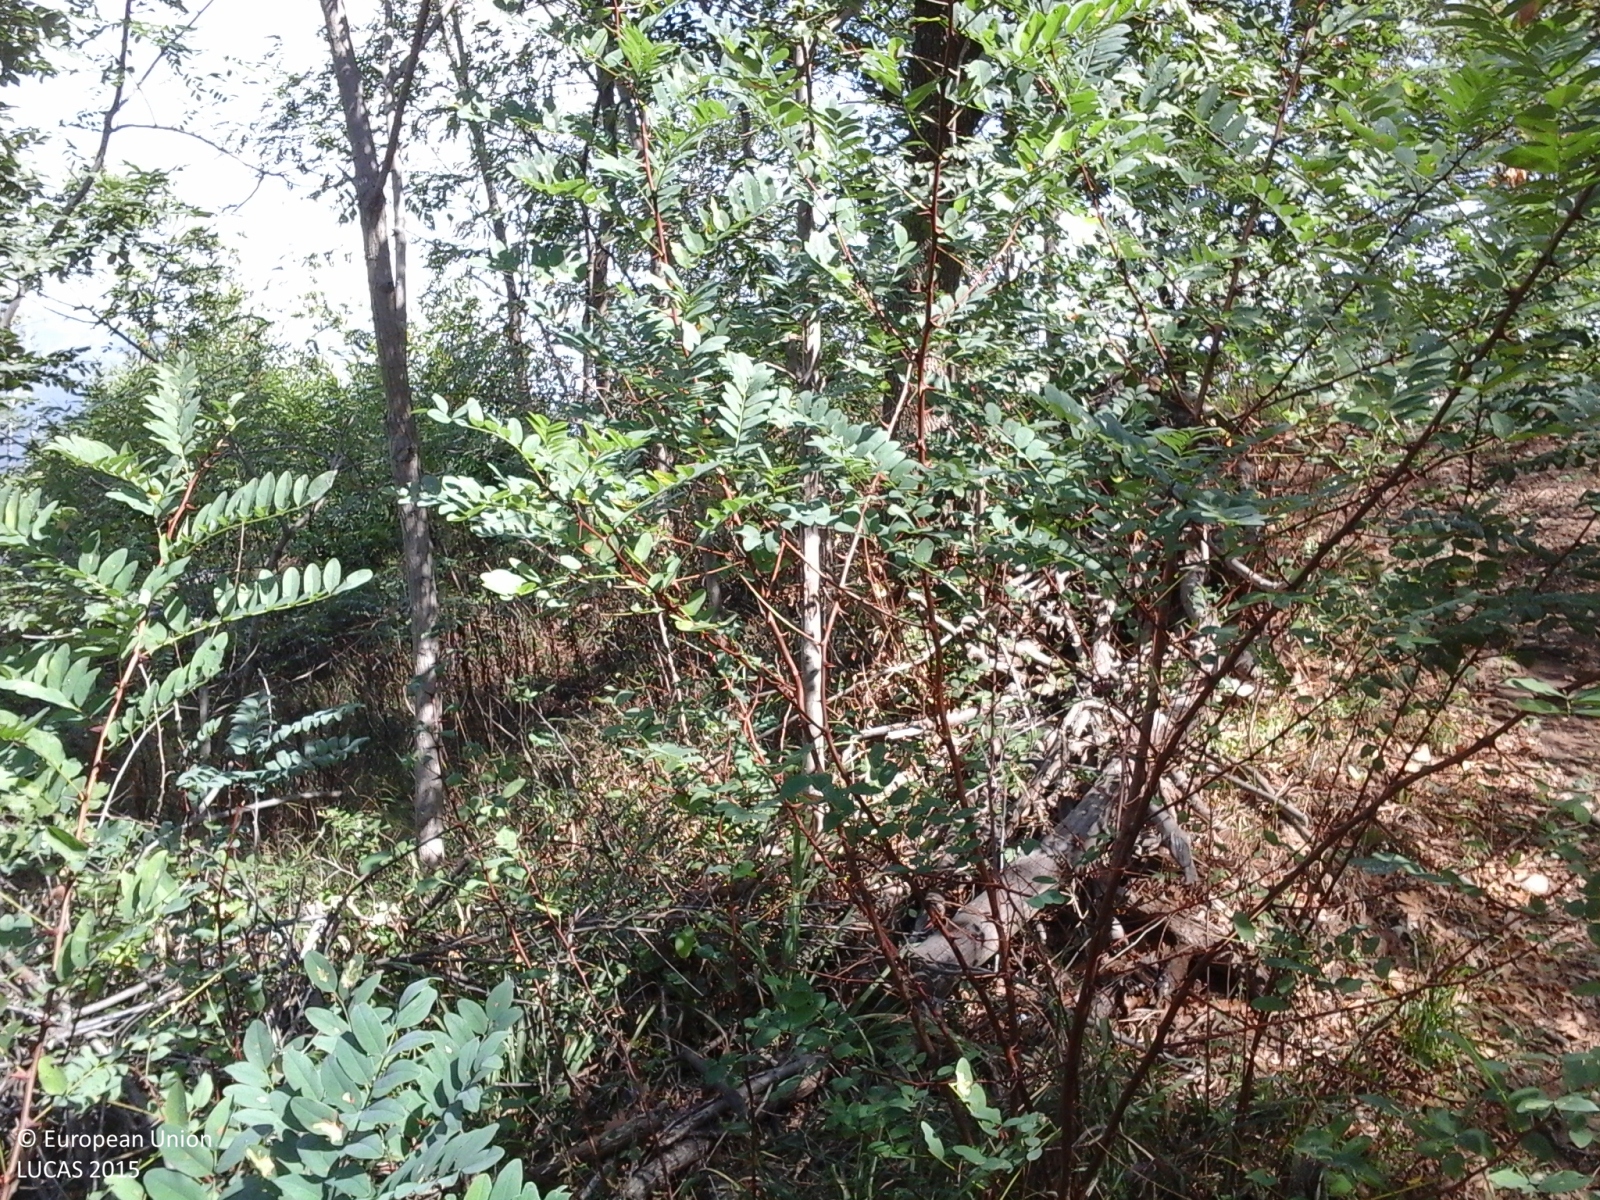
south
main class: Woodland
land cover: Broadleaved woodland
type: thermophilous deciduous forest
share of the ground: > 75 %
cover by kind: broadleaved forest trees 100 %
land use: Semi-natural and natural areas not in use
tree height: > 5 m
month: September
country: IT
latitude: 44.3763
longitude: 8.5349
